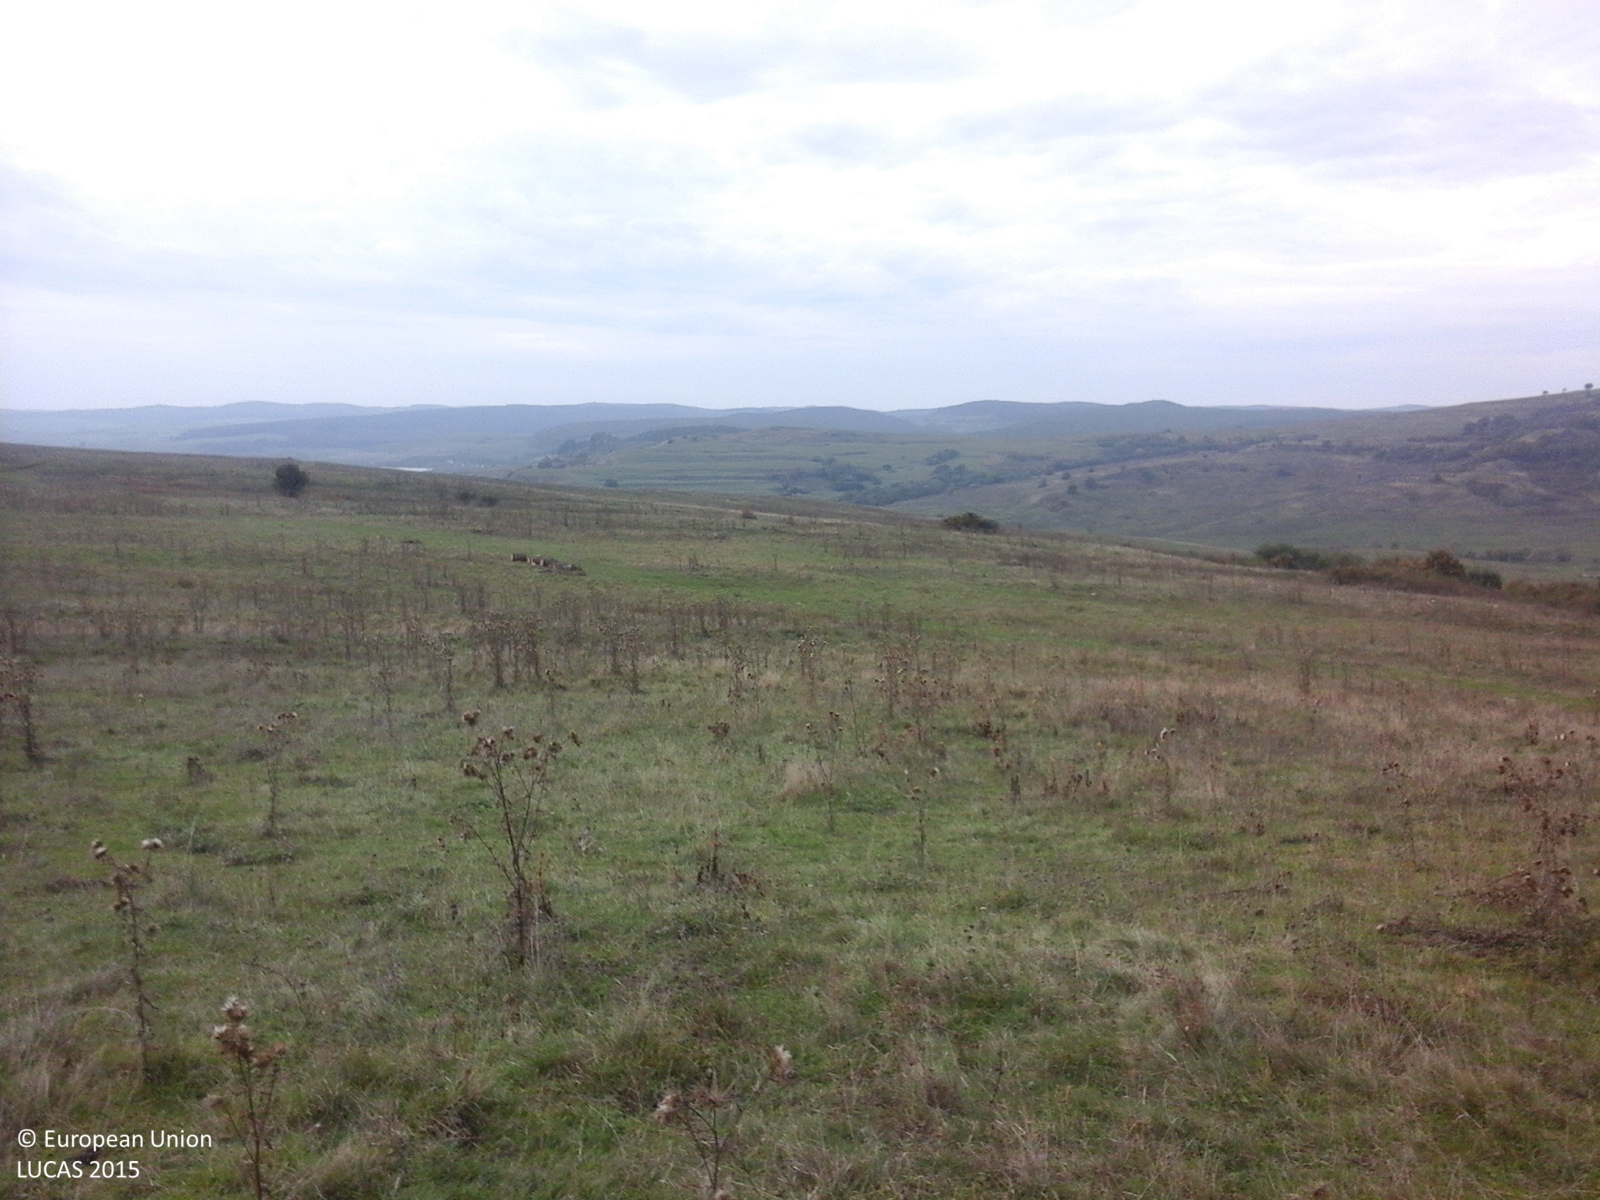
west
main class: Grassland
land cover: Spontaneously vegetated surfaces
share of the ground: > 75 %
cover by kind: herbaceous plants 100 %
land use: Agriculture (excluding fallow land and kitchen gardens)
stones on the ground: < 10 %
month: October
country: RO
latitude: 46.0733
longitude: 24.8699
